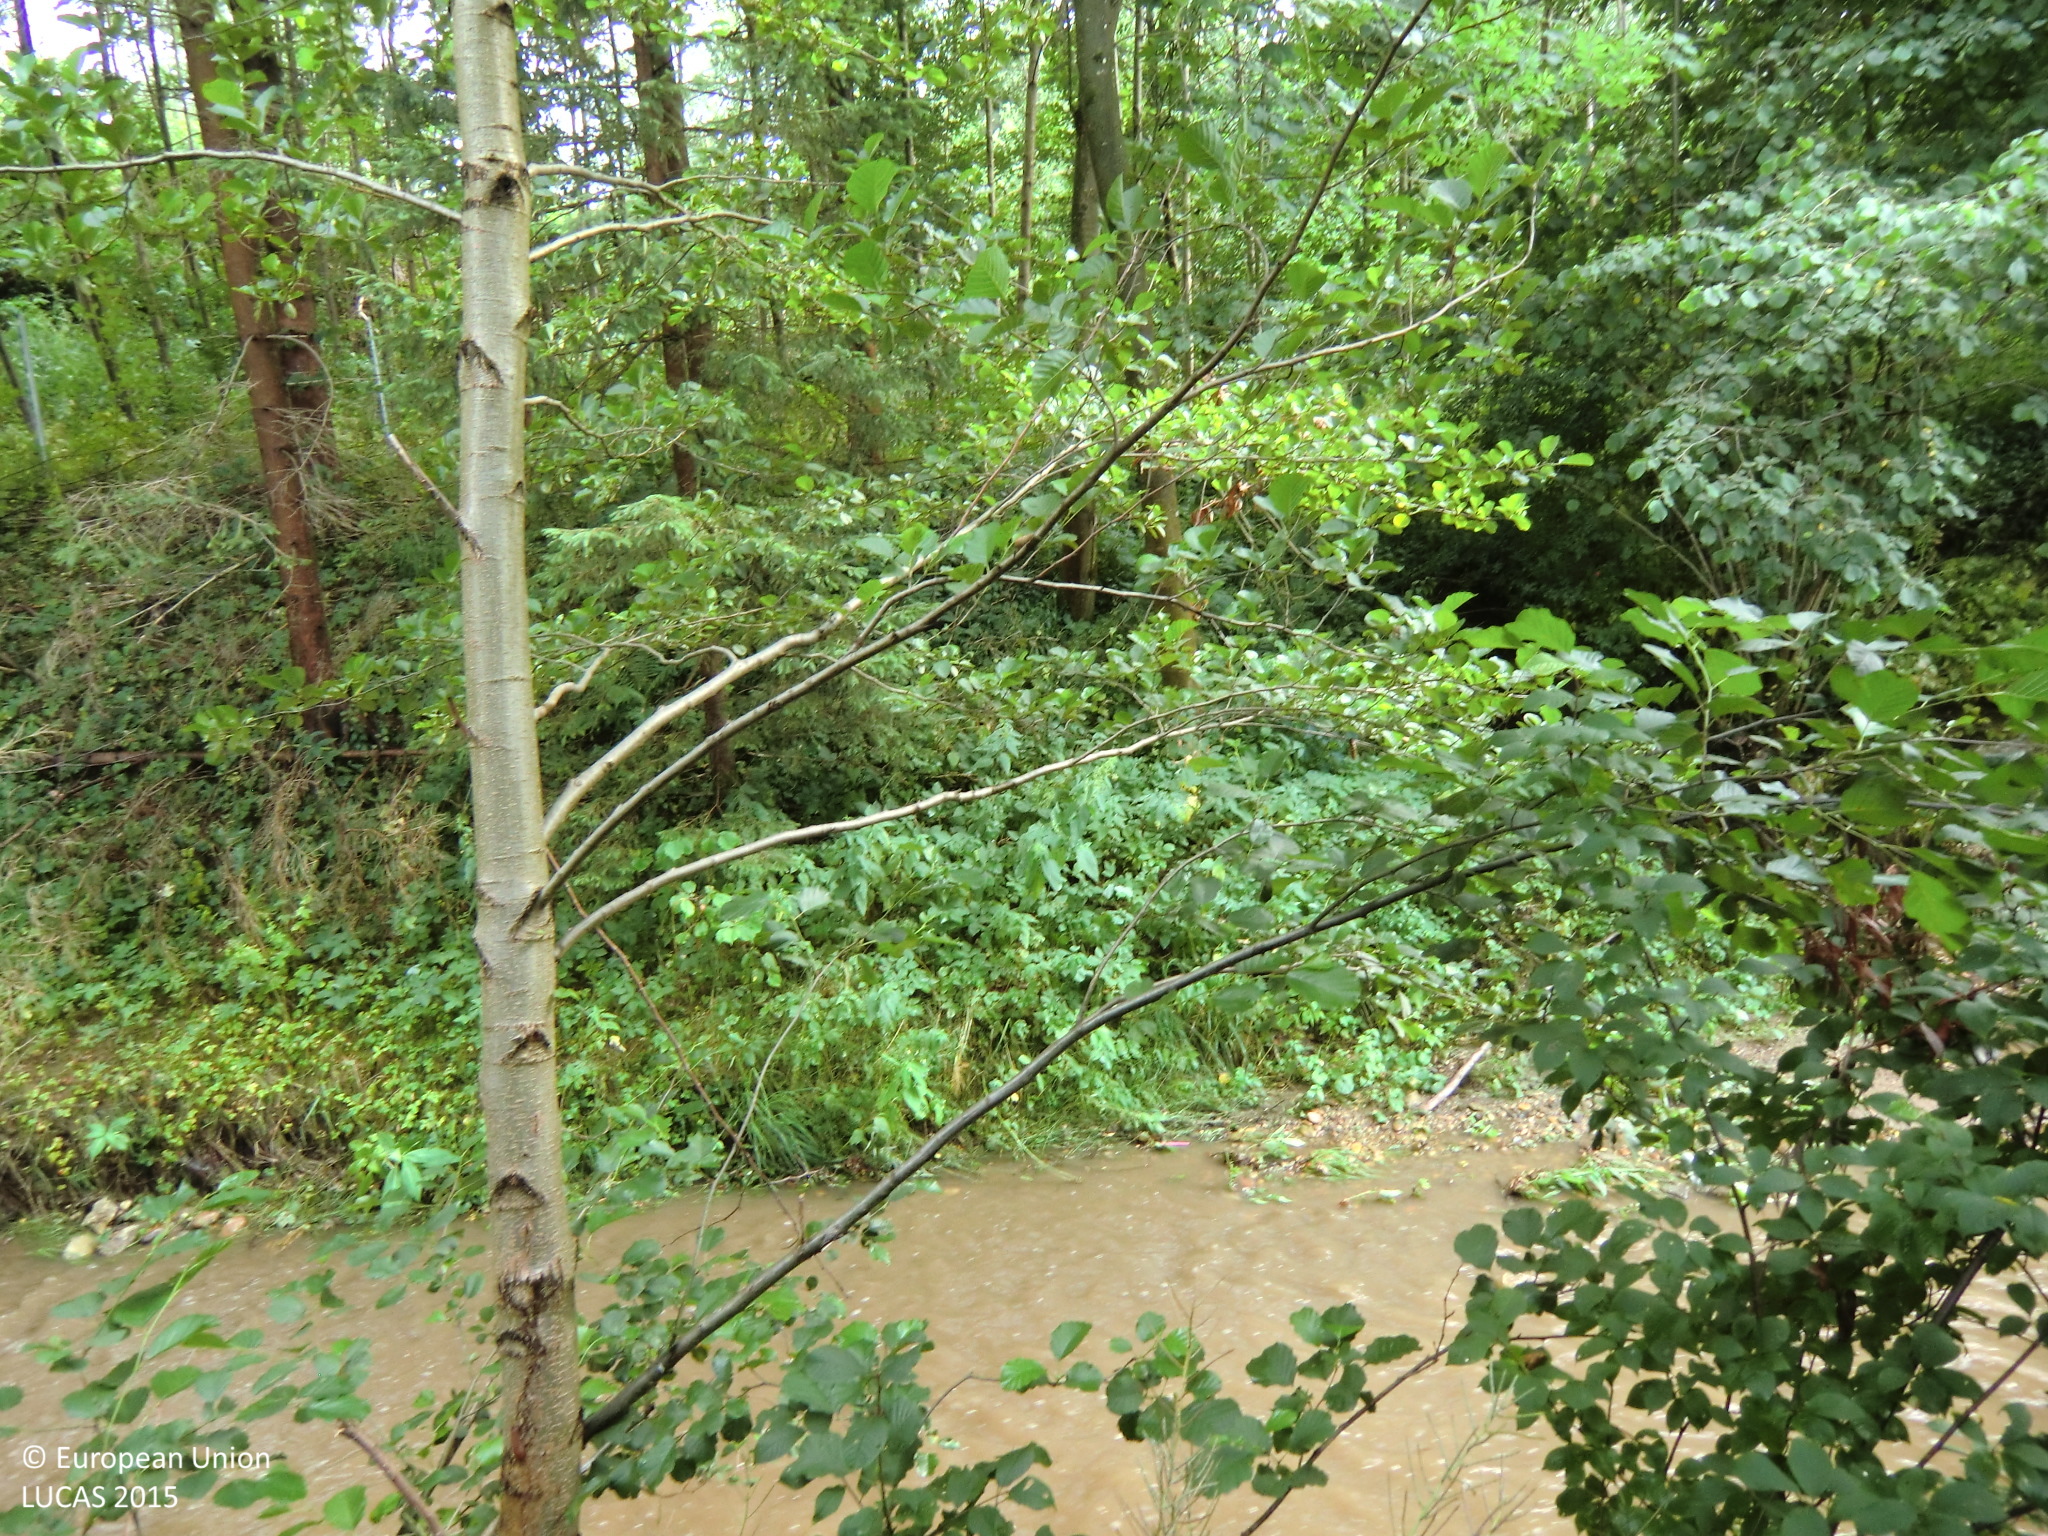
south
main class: Woodland
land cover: Broadleaved woodland
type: floodplain forest
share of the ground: > 75 %
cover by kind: broadleaved forest trees 90 %, herbaceous plants 10 %
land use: Semi-natural and natural areas not in use
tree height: > 5 m
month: July
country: AT
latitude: 47.0765
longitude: 15.4918
